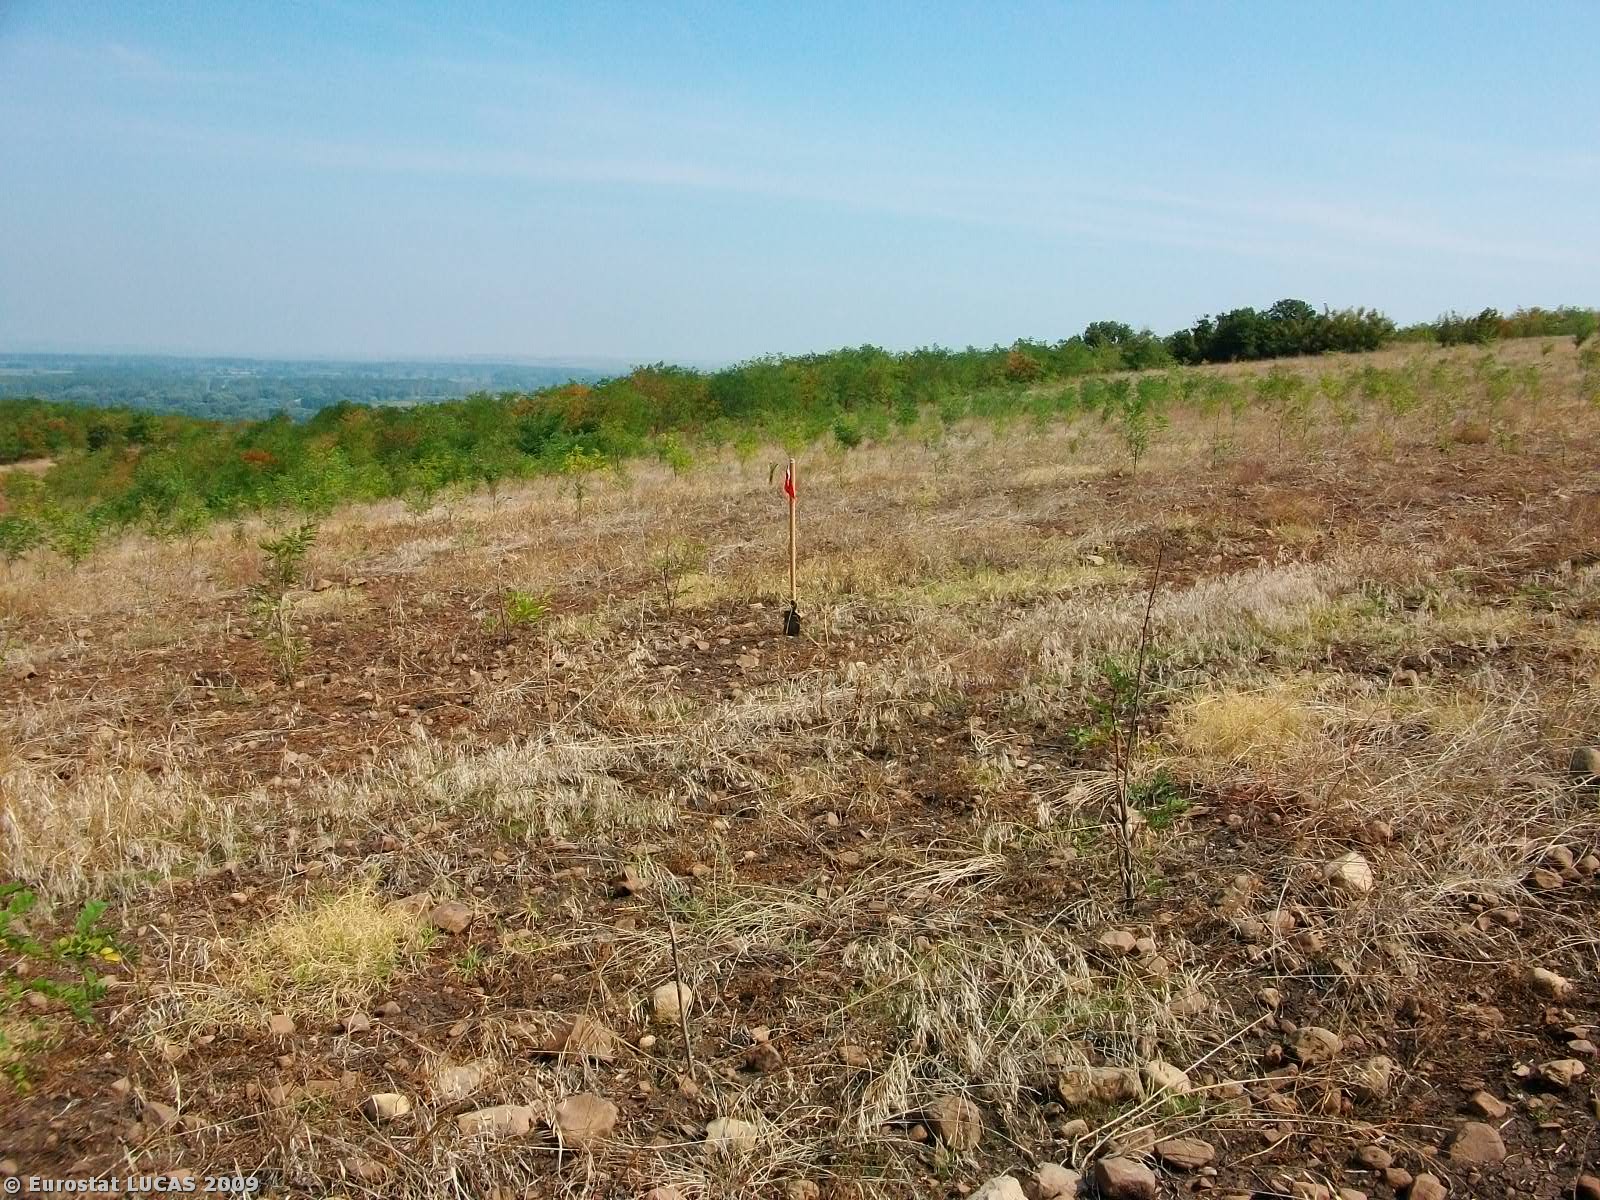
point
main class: Grassland
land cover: Grassland with sparse tree/shrub cover
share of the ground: 50 - 75 %
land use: Forestry
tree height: > 5 m
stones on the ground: 10 - 25 %
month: September
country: GR
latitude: 40.9718
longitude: 26.3116
